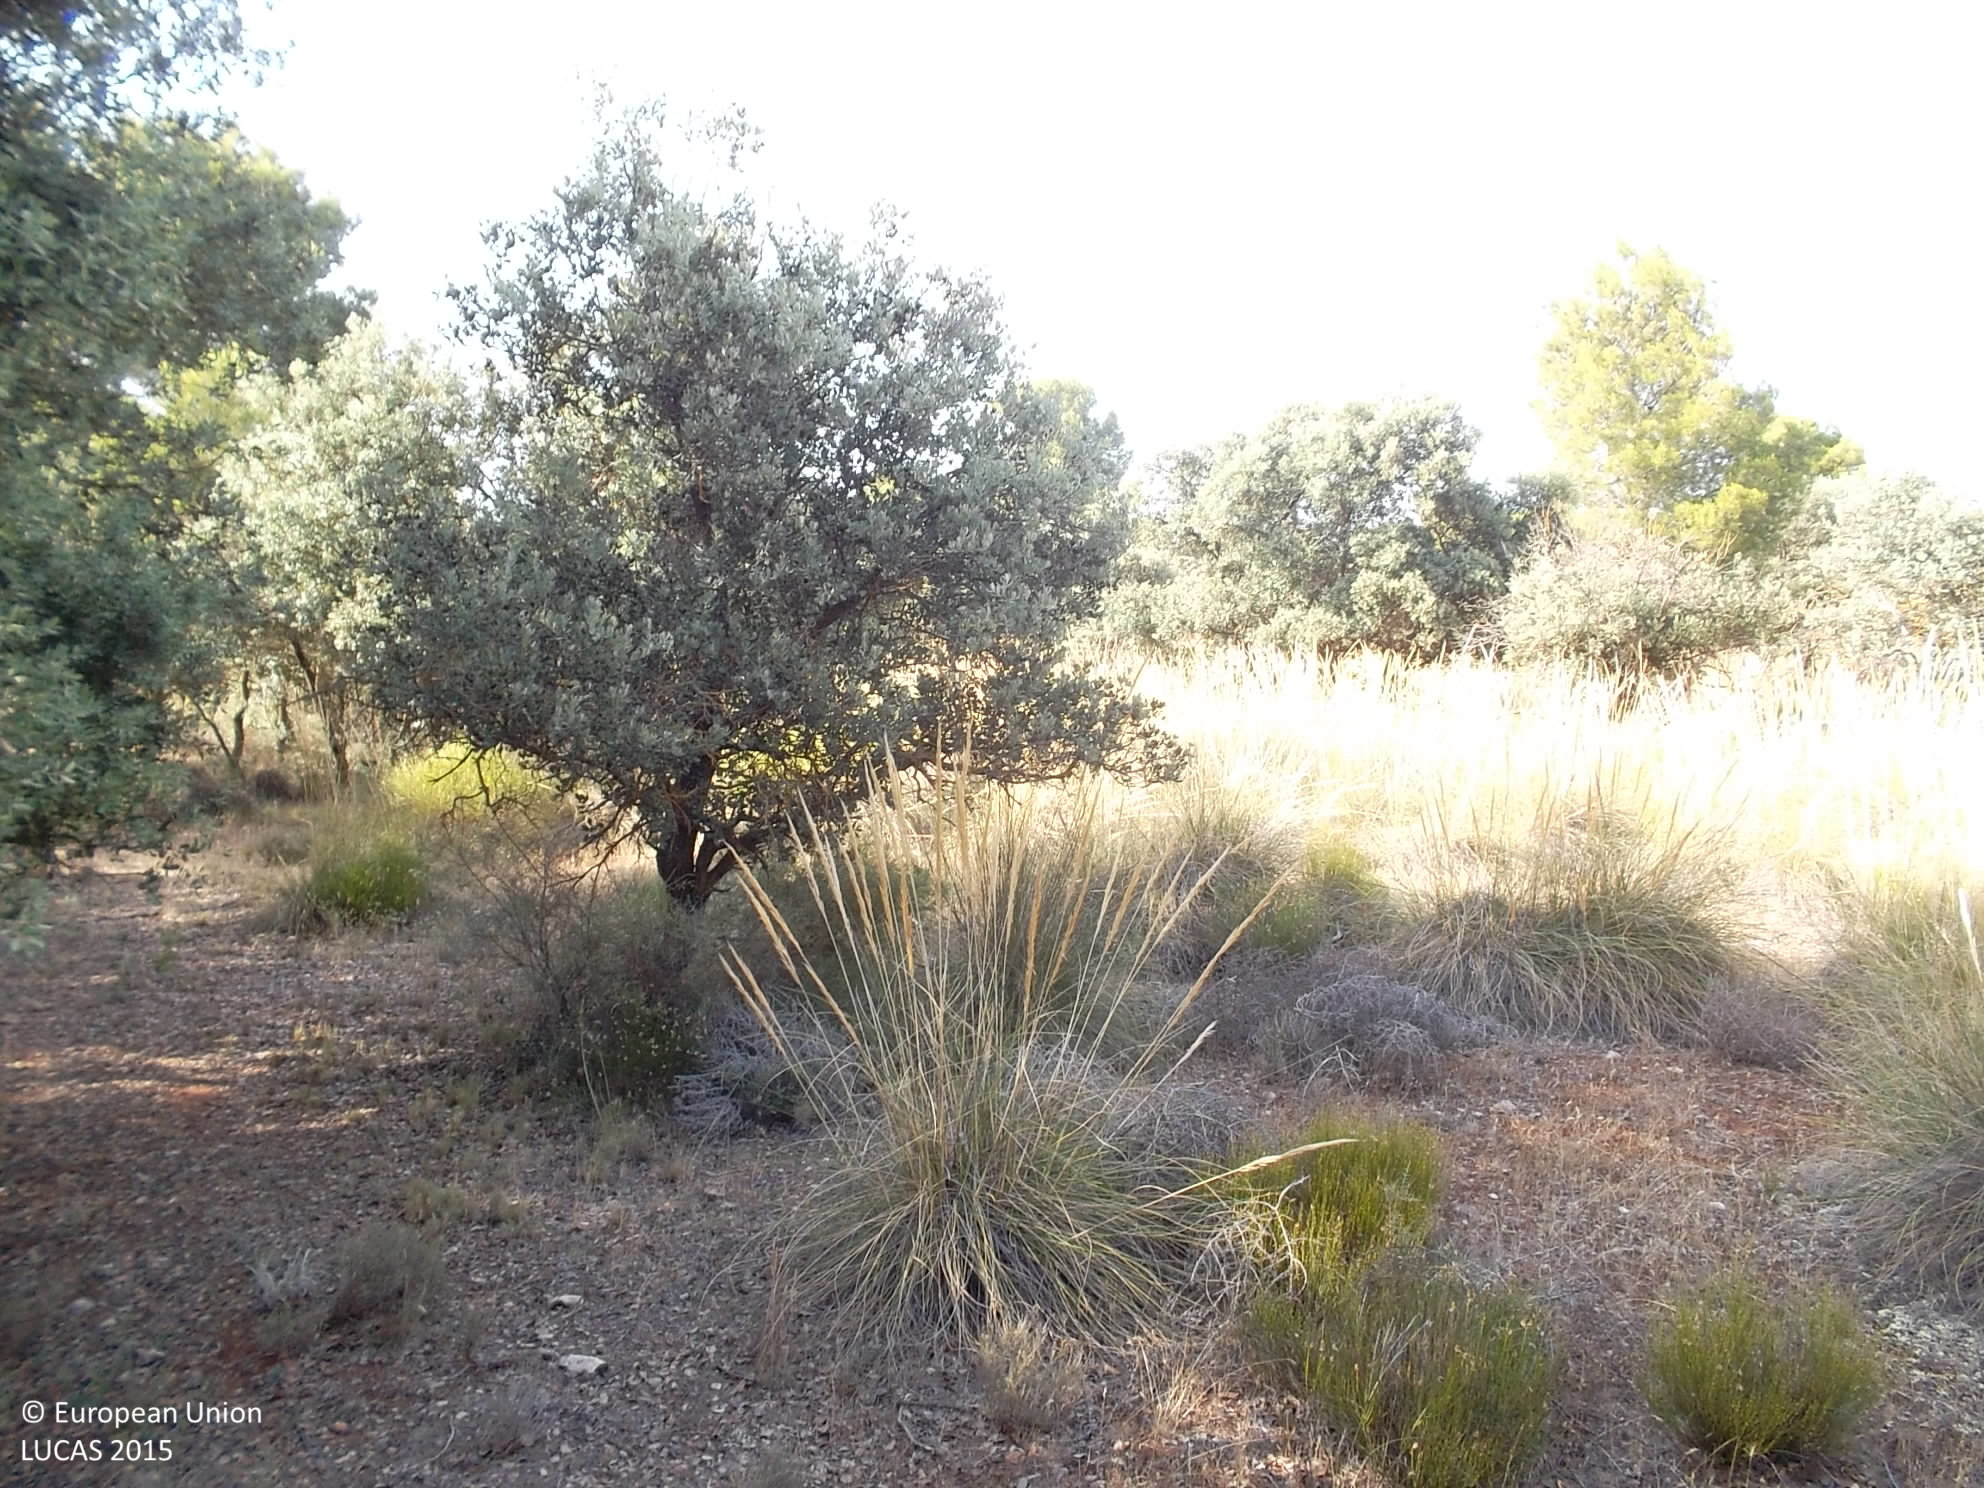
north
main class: Woodland
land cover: Broadleaved woodland
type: broadleaved evergreen forest
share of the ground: 50 - 75 %
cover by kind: broadleaved forest trees 40 %, shrubs 30 %, herbaceous plants 20 %, unconsolidated bare surface 10 %
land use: Semi-natural and natural areas not in use
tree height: > 5 m
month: June
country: ES
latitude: 37.6982
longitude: -2.8407
